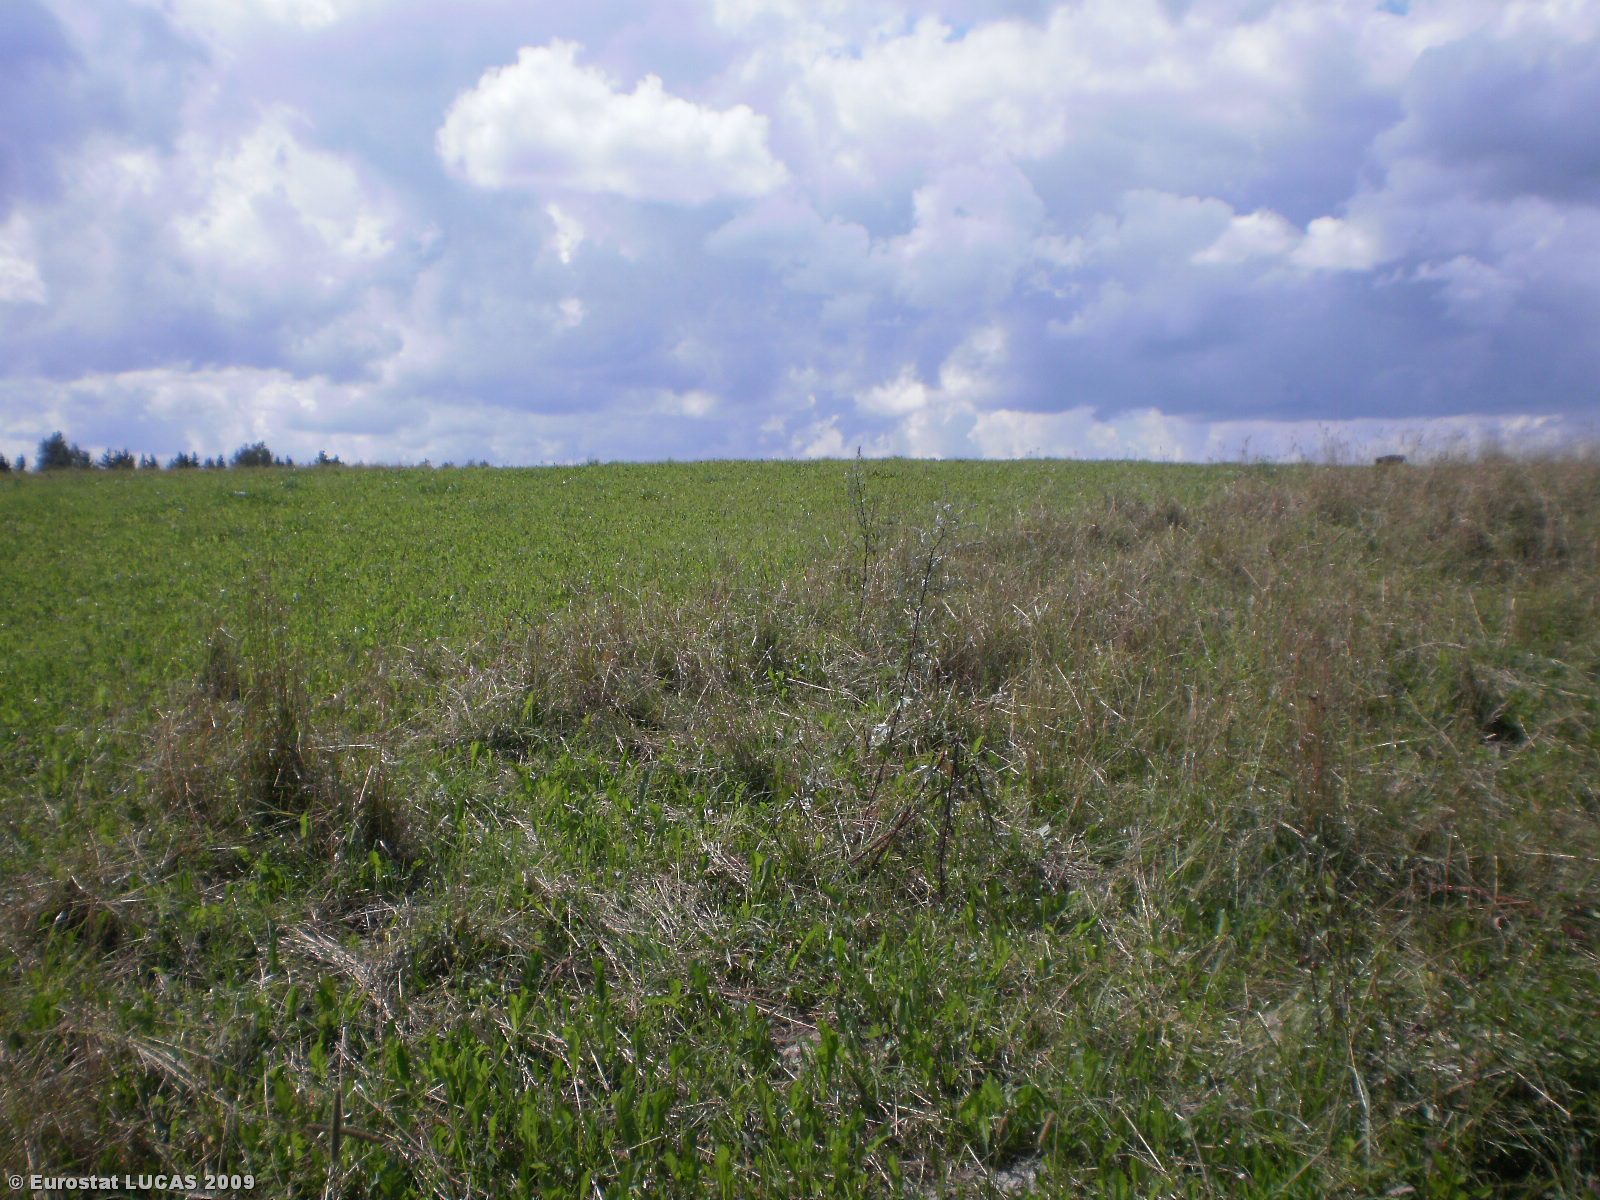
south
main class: Grassland
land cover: Grassland without tree/shrub cover
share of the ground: > 75 %
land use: Agriculture (excluding fallow land and kitchen gardens)
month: July
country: LT
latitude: 55.9632
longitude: 25.7152
